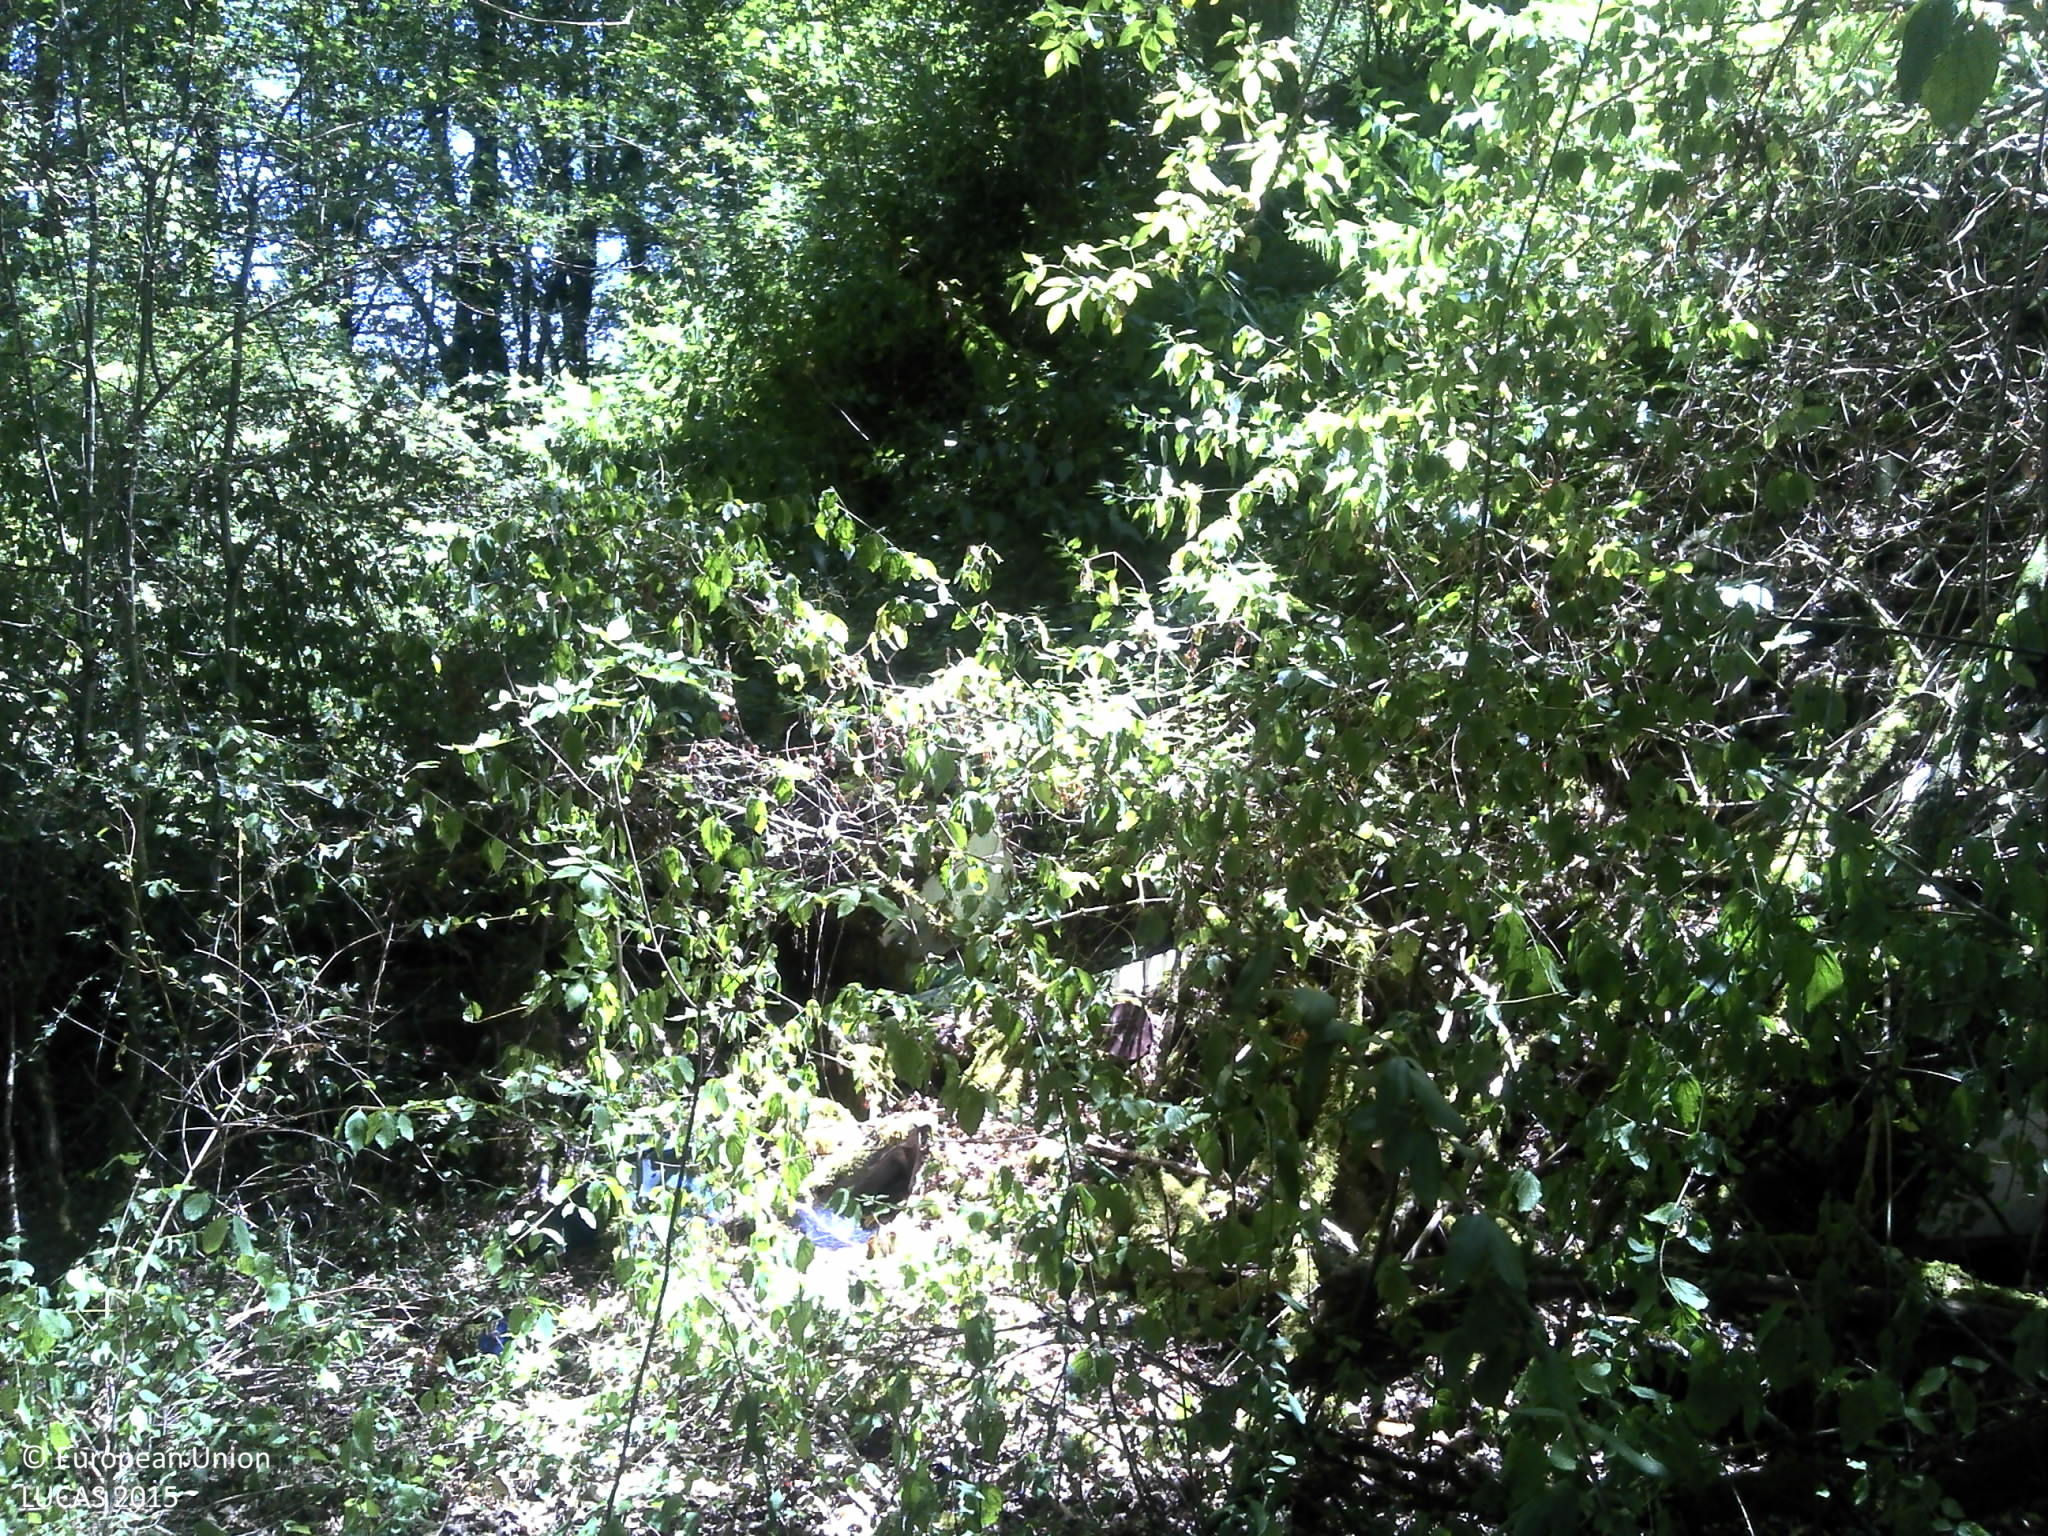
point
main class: Woodland
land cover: Broadleaved woodland
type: thermophilous deciduous forest
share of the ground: > 75 %
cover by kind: broadleaved forest trees 65 %, herbaceous plants 20 %, unconsolidated bare surface 5 %
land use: Abandoned areas
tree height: > 5 m
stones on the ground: < 10 %
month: July
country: FR
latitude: 45.0528
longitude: 1.7307
